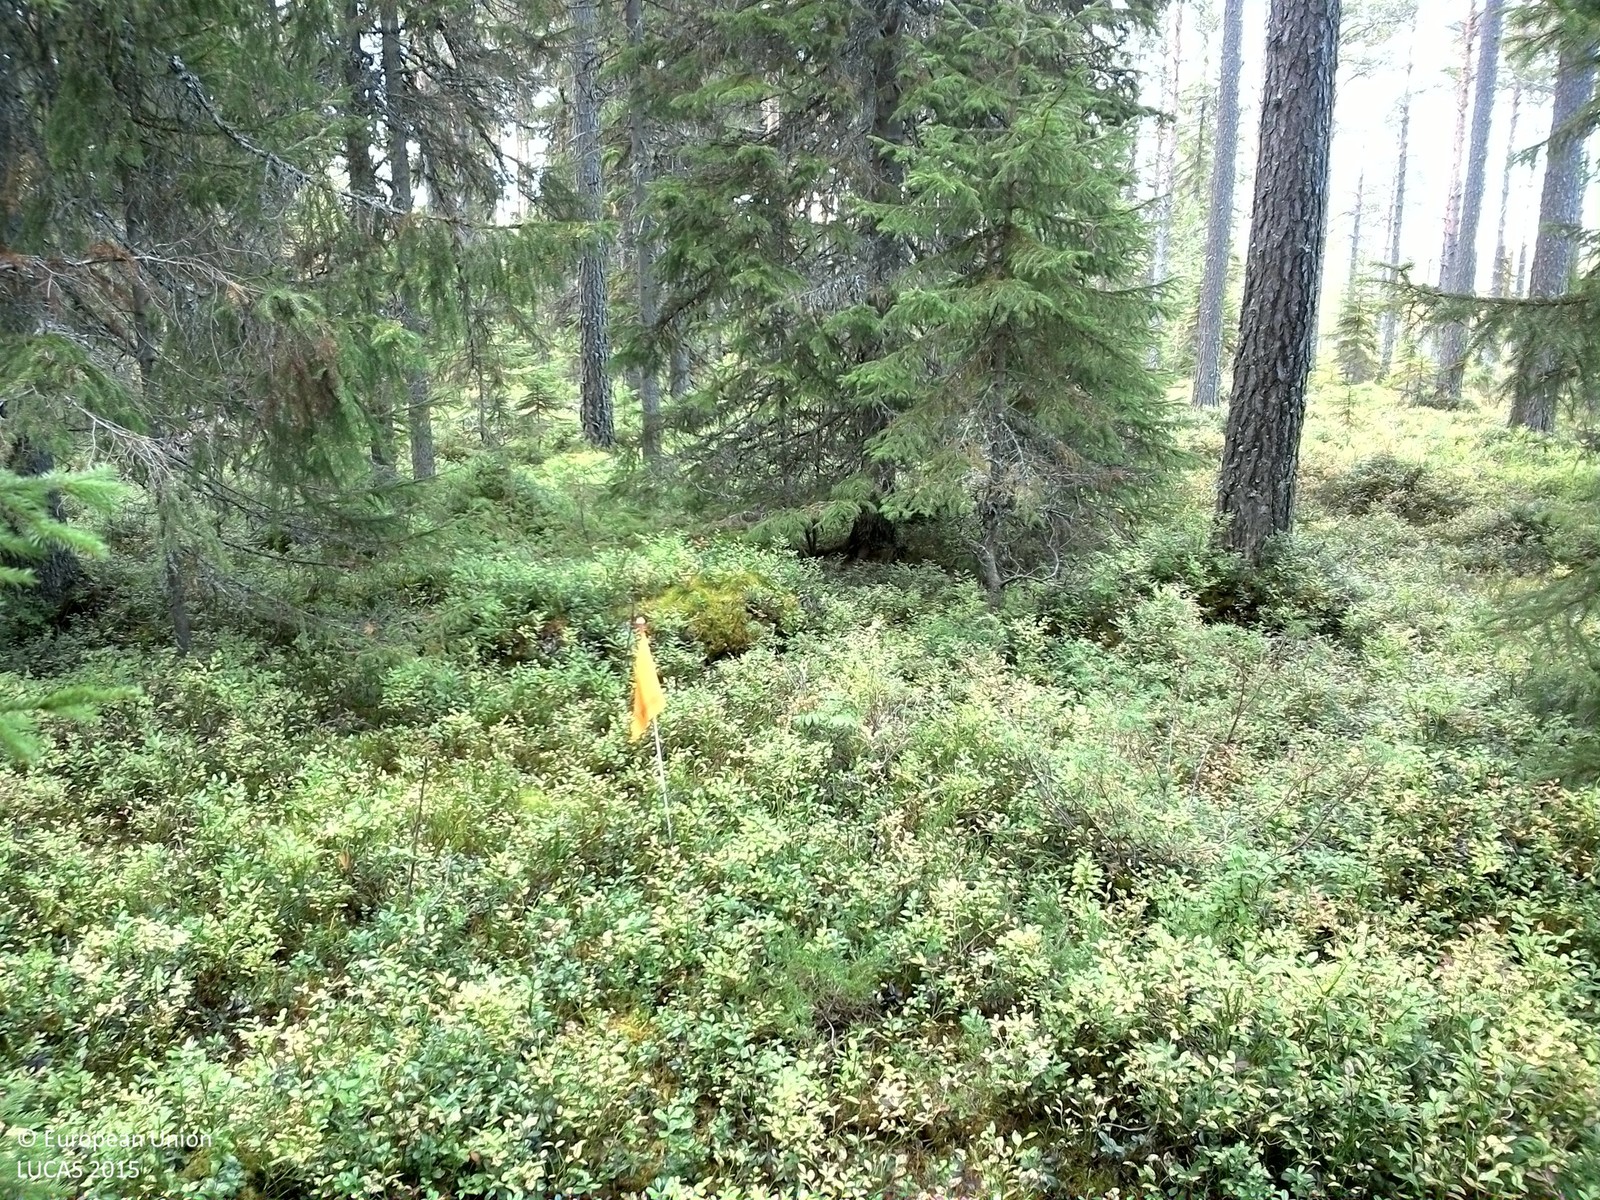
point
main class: Woodland
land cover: Other coniferous woodland
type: boreal forest
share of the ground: 50 - 75 %
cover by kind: coniferous forest trees 65 %, shrubs 30 %, lichens and mosses 5 %
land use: Forestry
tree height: > 5 m
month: September
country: SE
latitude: 61.3223
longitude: 15.4207
